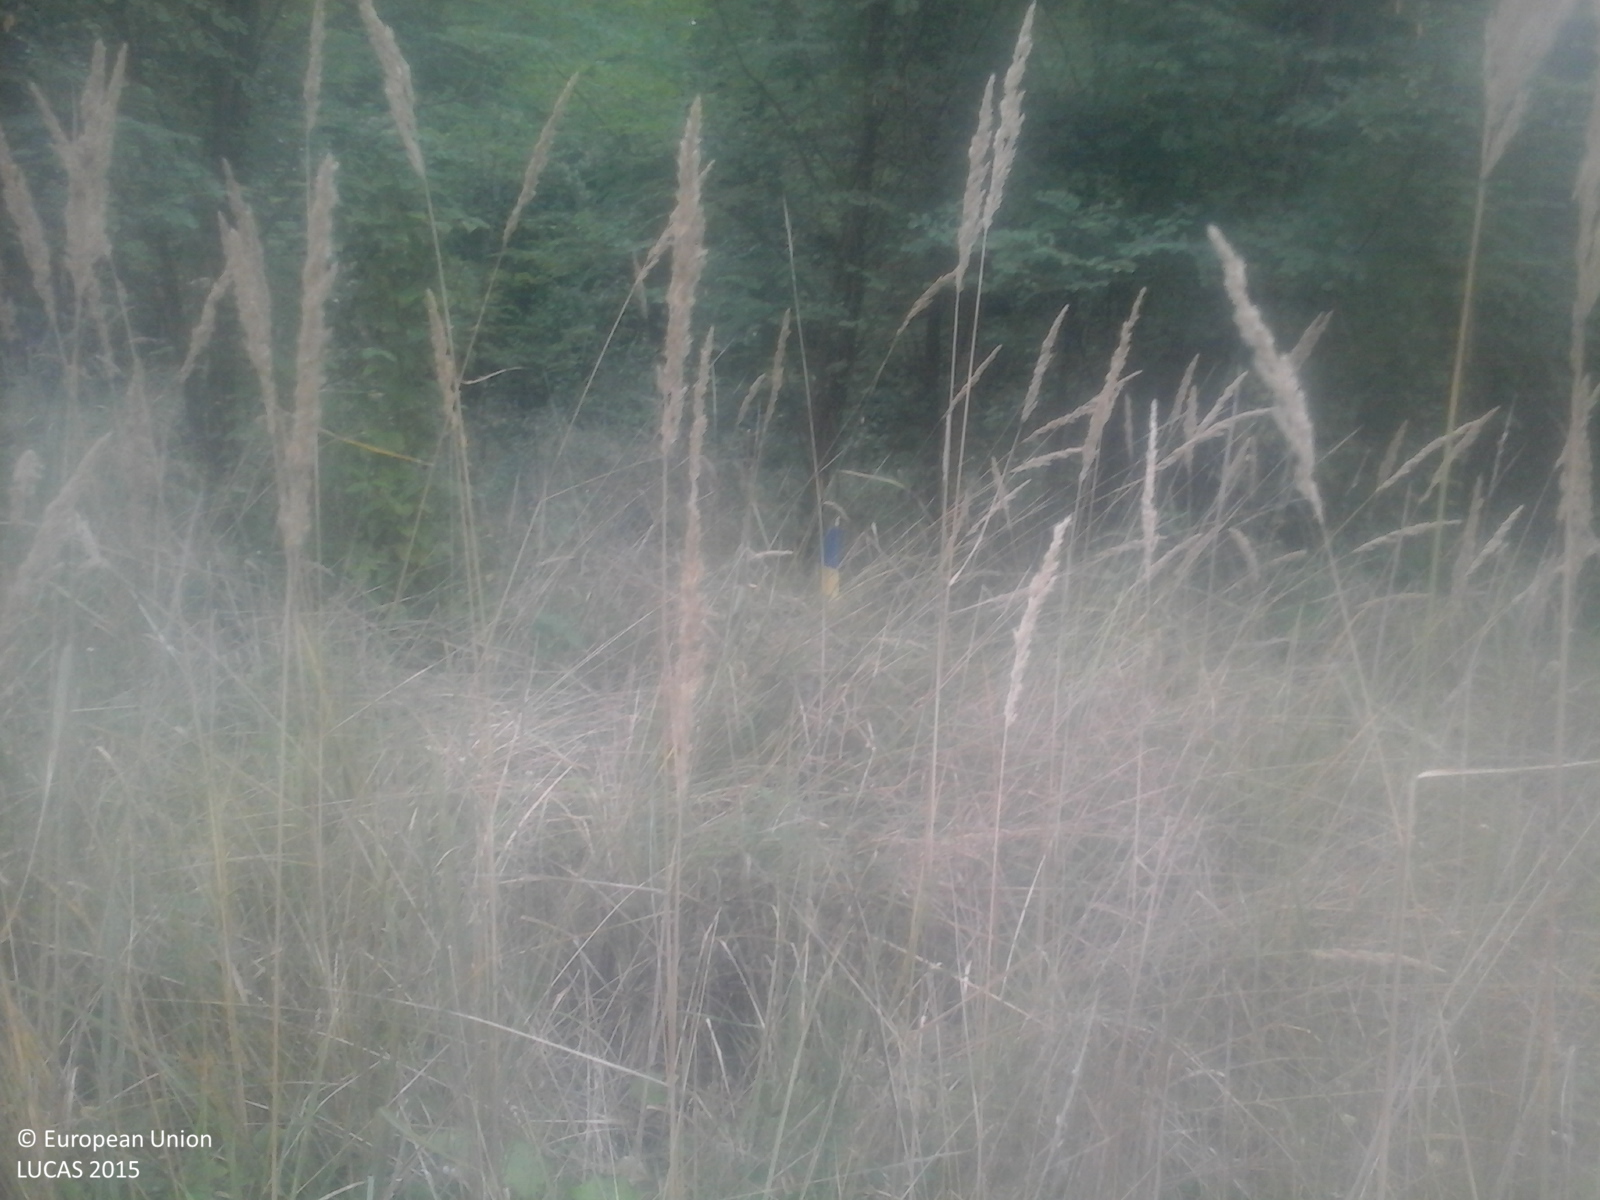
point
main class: Woodland
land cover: Broadleaved woodland
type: exotic forest
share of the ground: > 75 %
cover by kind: broadleaved forest trees 100 %
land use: Forestry
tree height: > 5 m
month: September
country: RO
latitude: 44.7832
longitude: 23.1817
